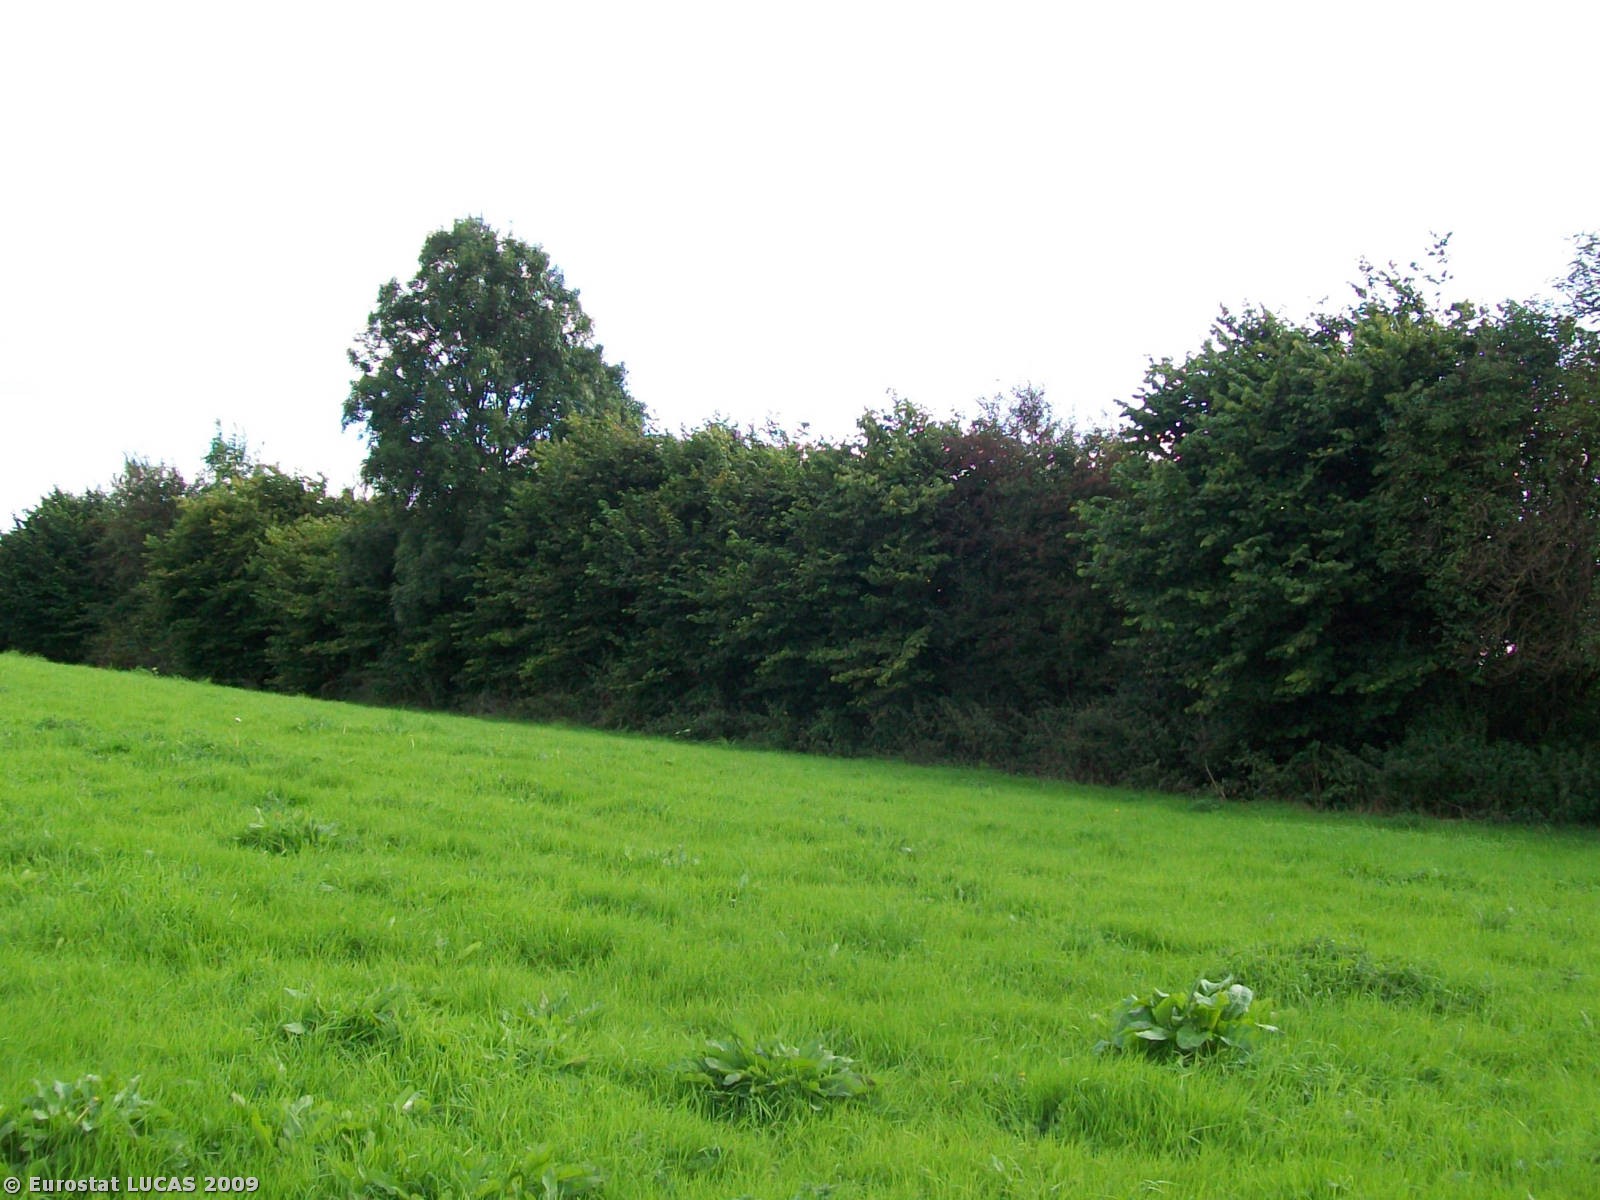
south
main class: Grassland
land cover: Grassland without tree/shrub cover
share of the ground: > 75 %
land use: Agriculture (excluding fallow land and kitchen gardens)
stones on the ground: < 10 %
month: September
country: IE
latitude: 53.0381
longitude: -7.8430
